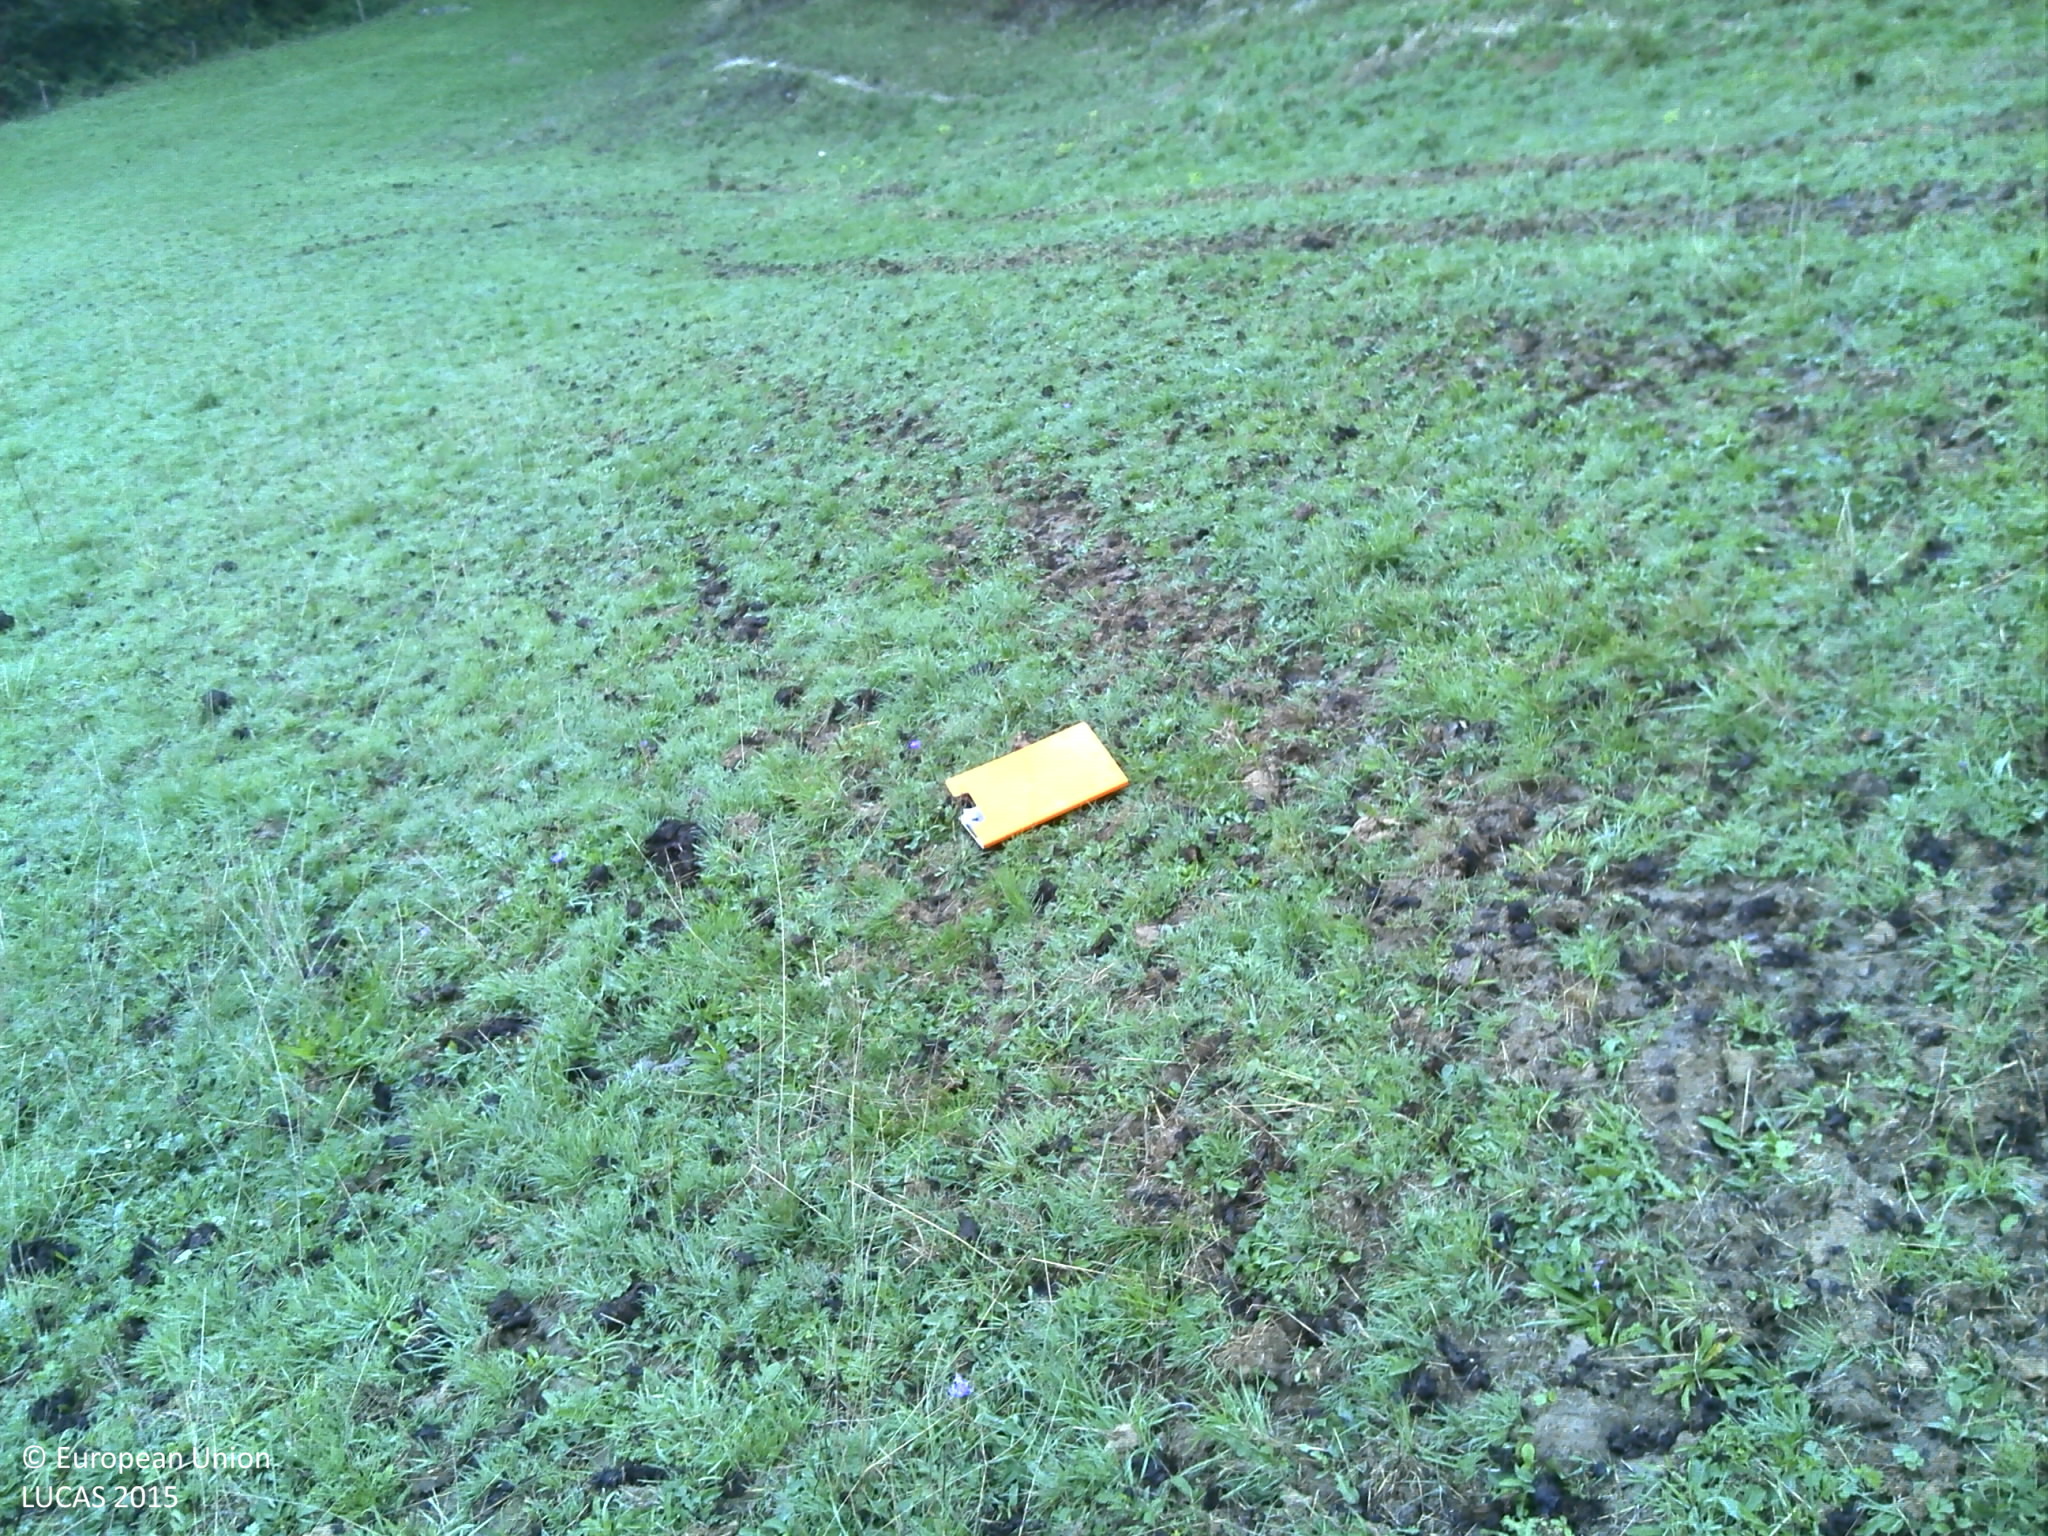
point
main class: Grassland
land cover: Grassland without tree/shrub cover
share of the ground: > 75 %
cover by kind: herbaceous plants 100 %
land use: Agriculture (excluding fallow land and kitchen gardens)
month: October
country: FR
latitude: 46.7809
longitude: 4.0401
